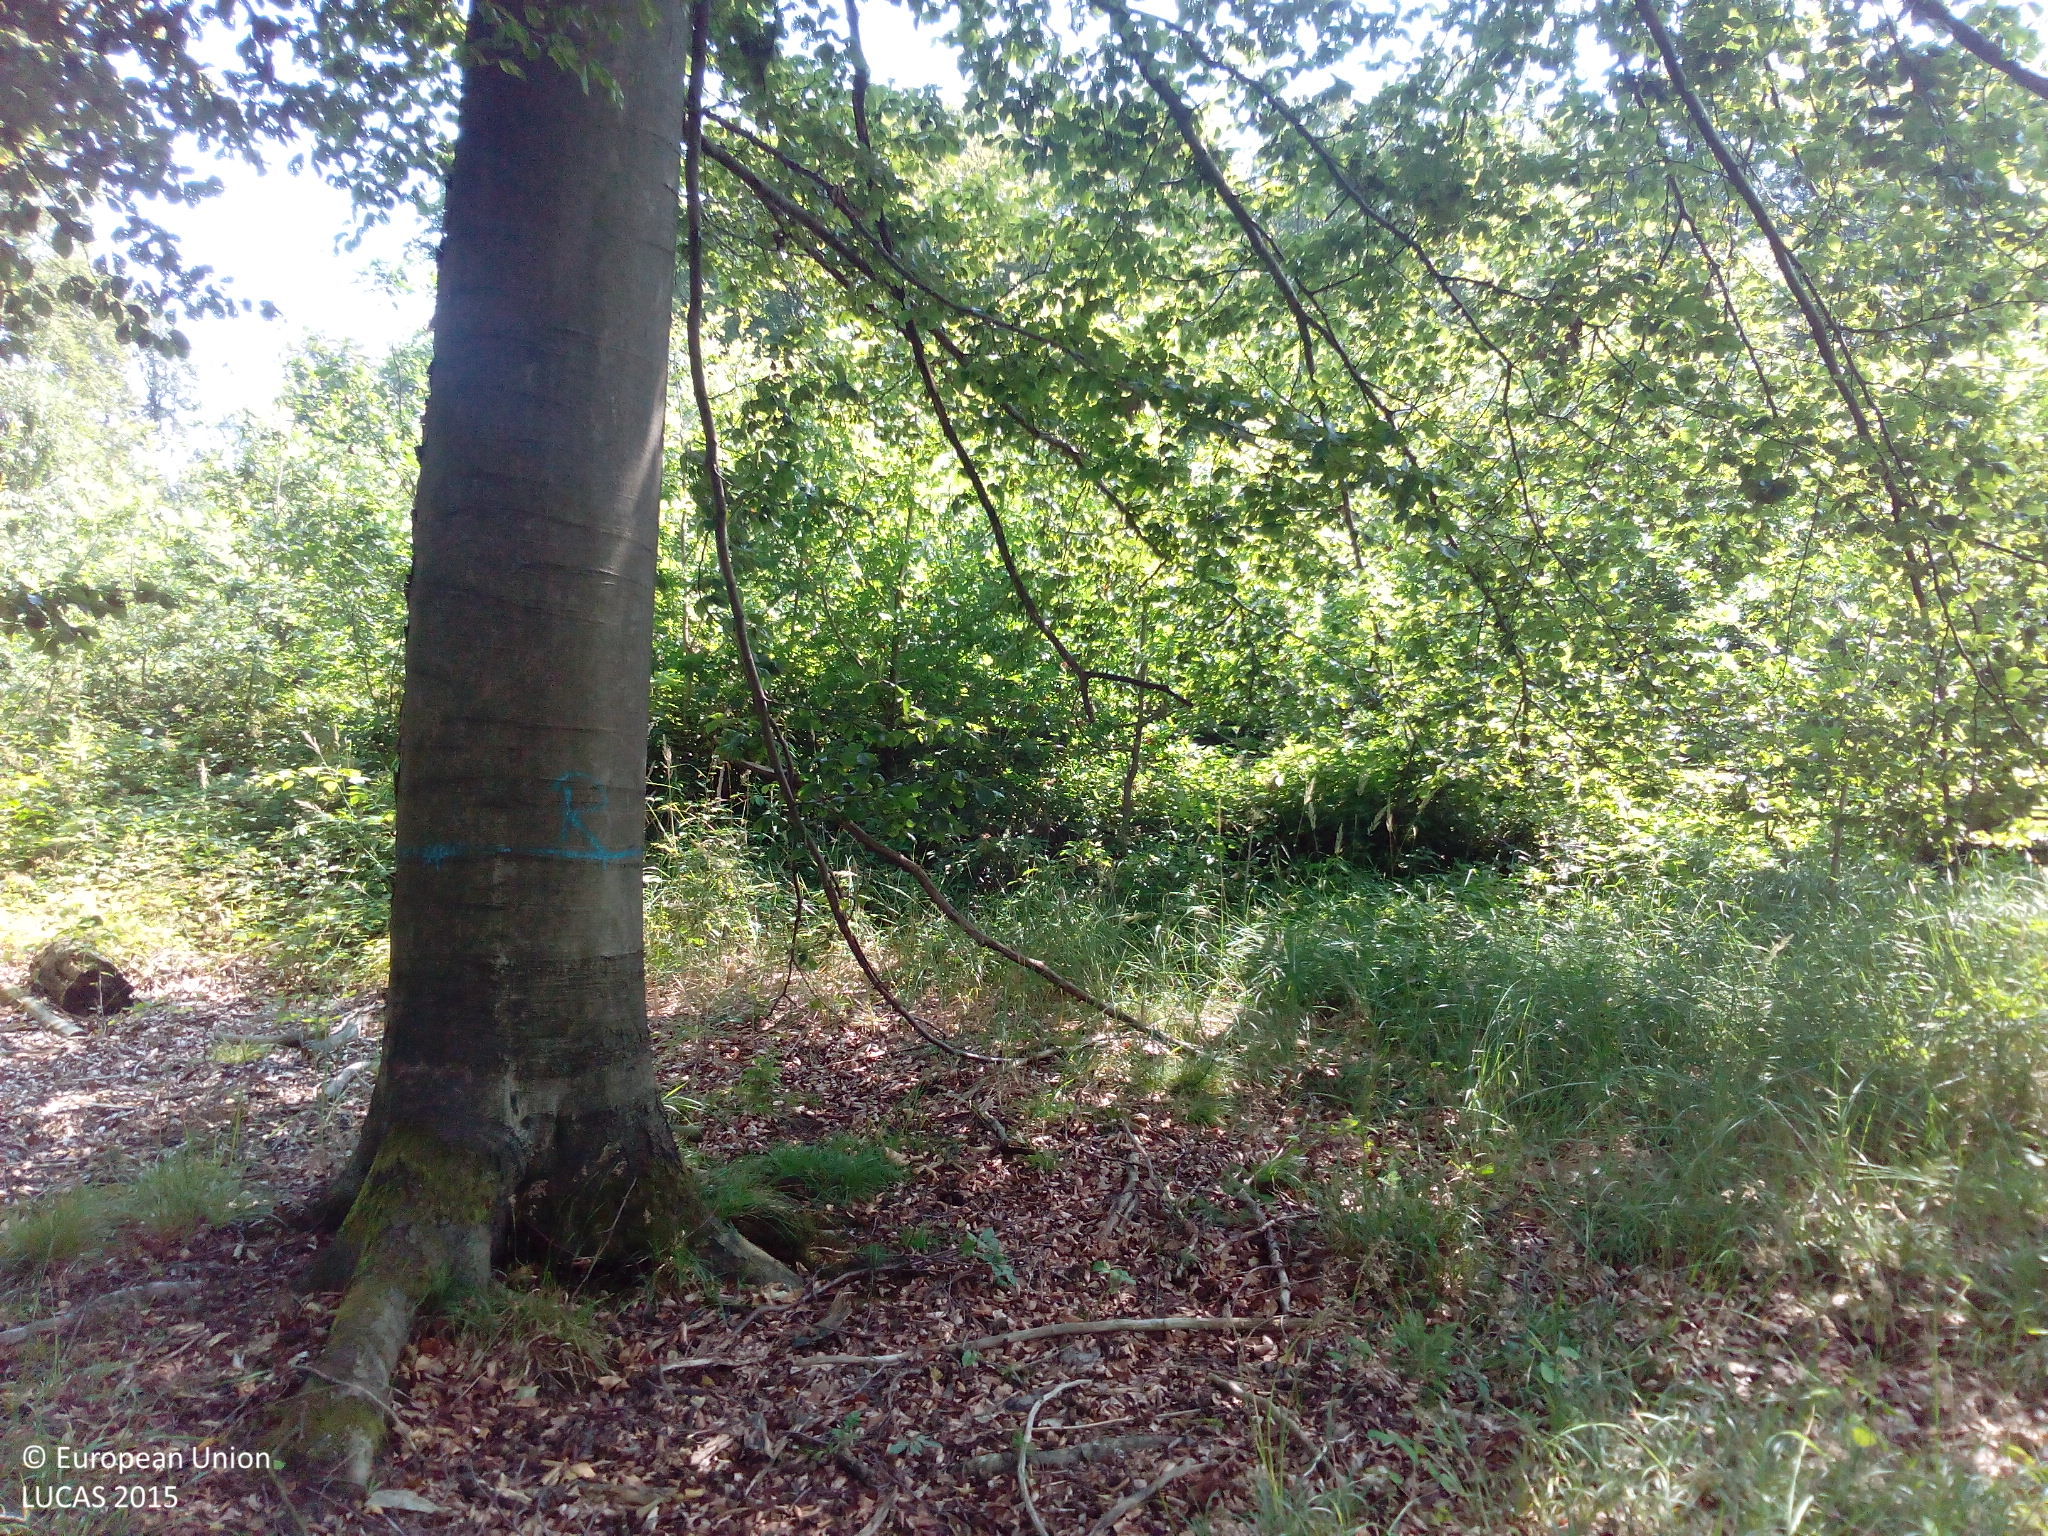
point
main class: Woodland
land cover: Broadleaved woodland
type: beech forest
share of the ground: > 75 %
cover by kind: broadleaved forest trees 90 %, herbaceous plants 10 %
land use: Forestry
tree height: < 5 m
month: August
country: DE
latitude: 52.0877
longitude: 9.2851
